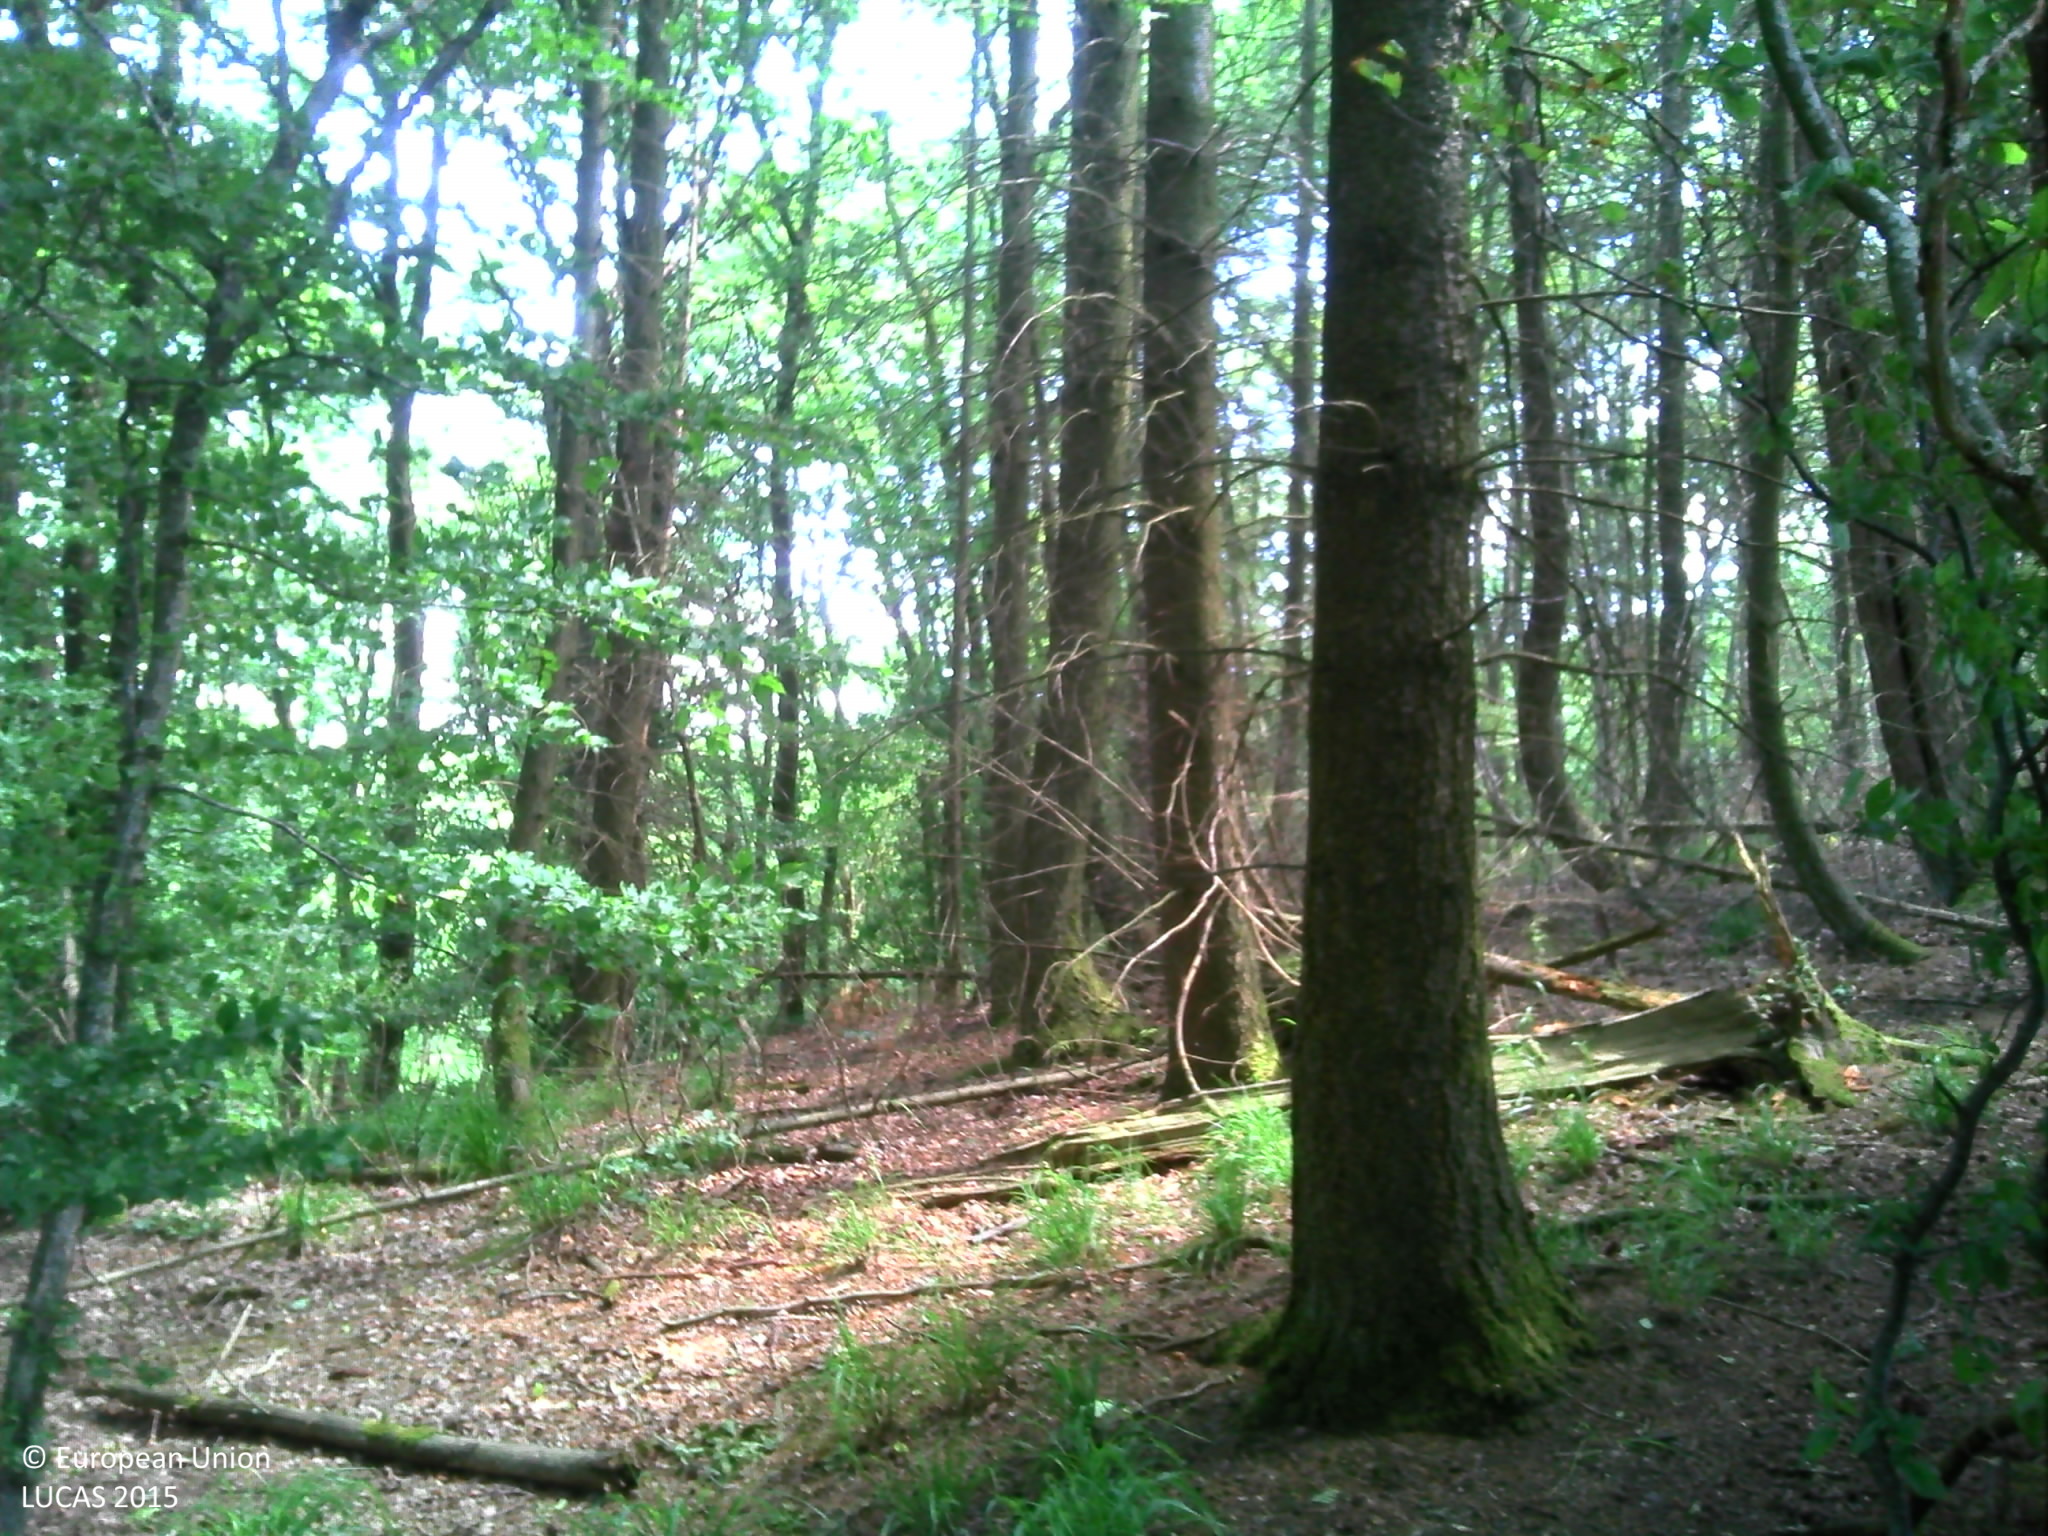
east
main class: Woodland
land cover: Broadleaved woodland
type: beech forest
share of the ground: > 75 %
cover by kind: broadleaved forest trees 85 %, coniferous forest trees 10 %, herbaceous plants 5 %
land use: Forestry
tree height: > 5 m
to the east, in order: Broadleaved woodland; Spruce dominated coniferous woodland; Broadleaved woodland; Spruce dominated coniferous woodland; Broadleaved woodland
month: June
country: LU
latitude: 49.8932
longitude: 5.8647
